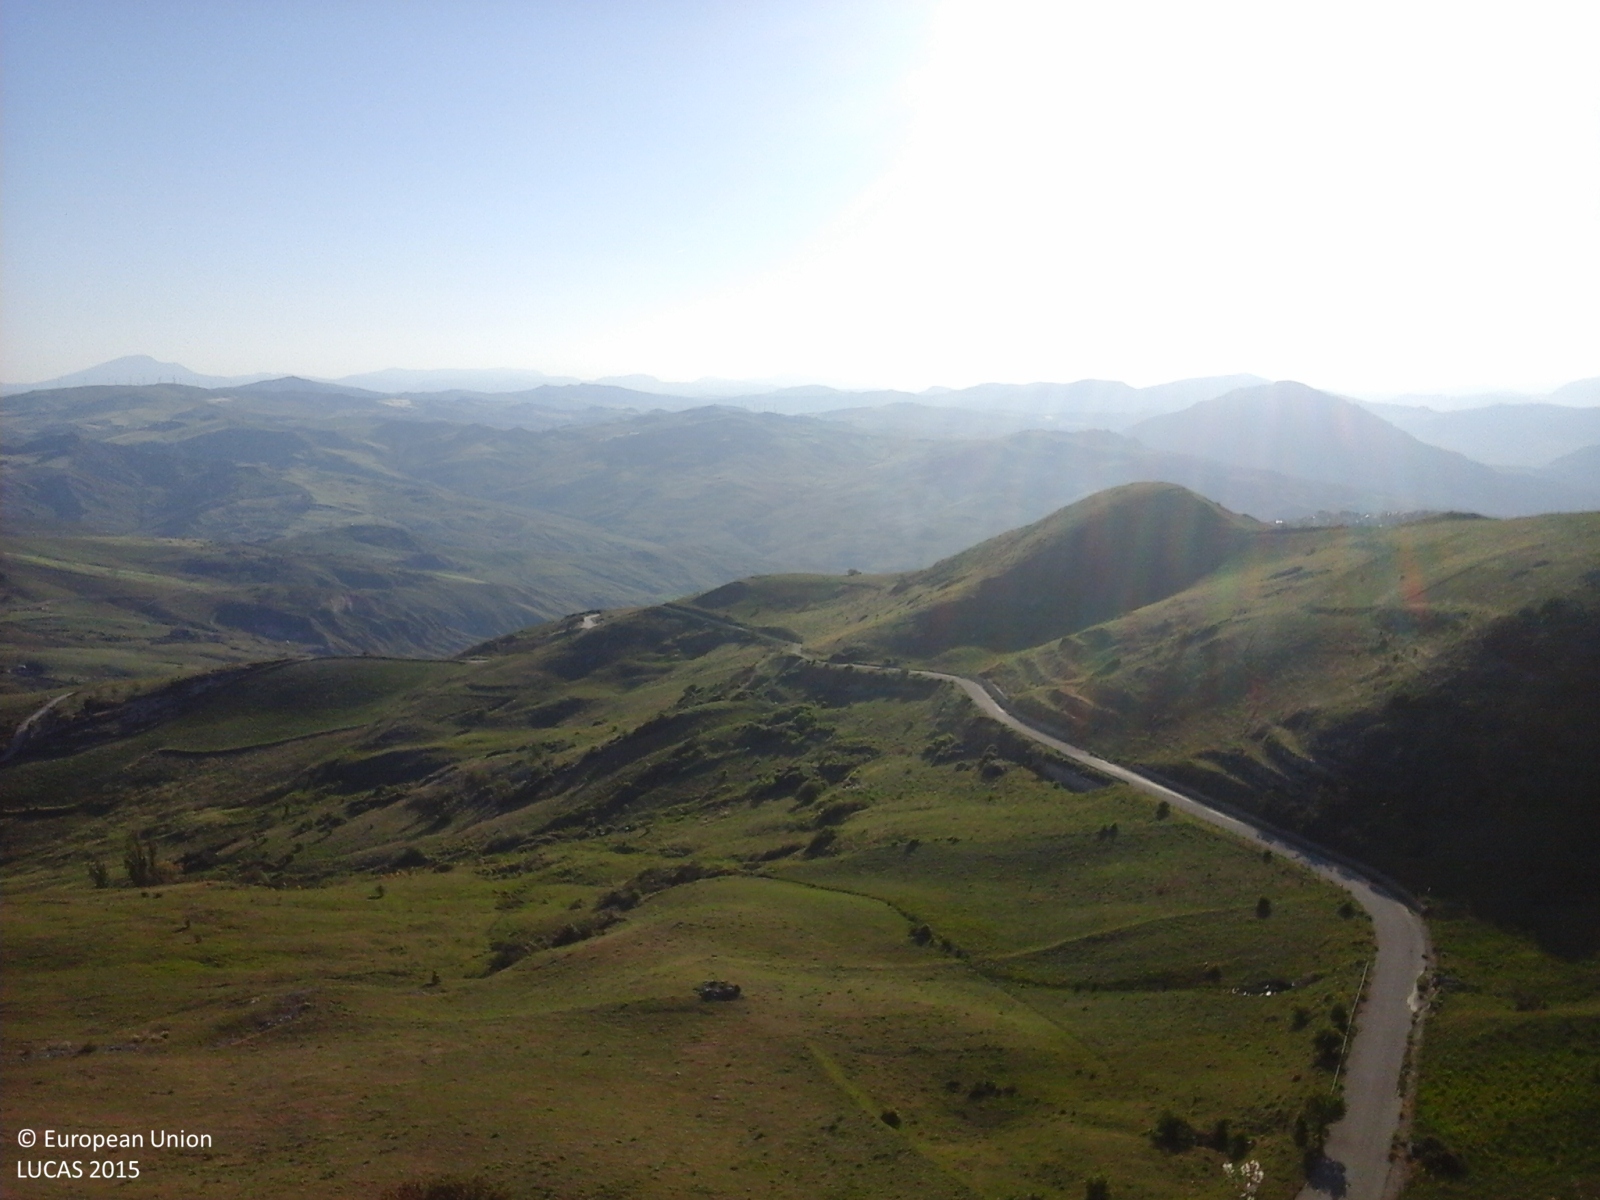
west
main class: Grassland
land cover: Grassland without tree/shrub cover
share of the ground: > 75 %
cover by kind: herbaceous plants 90 %, consolidated bare surface 5 %, unconsolidated bare surface 5 %
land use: Agriculture (excluding fallow land and kitchen gardens)
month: May
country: IT
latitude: 37.8077
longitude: 14.0261
